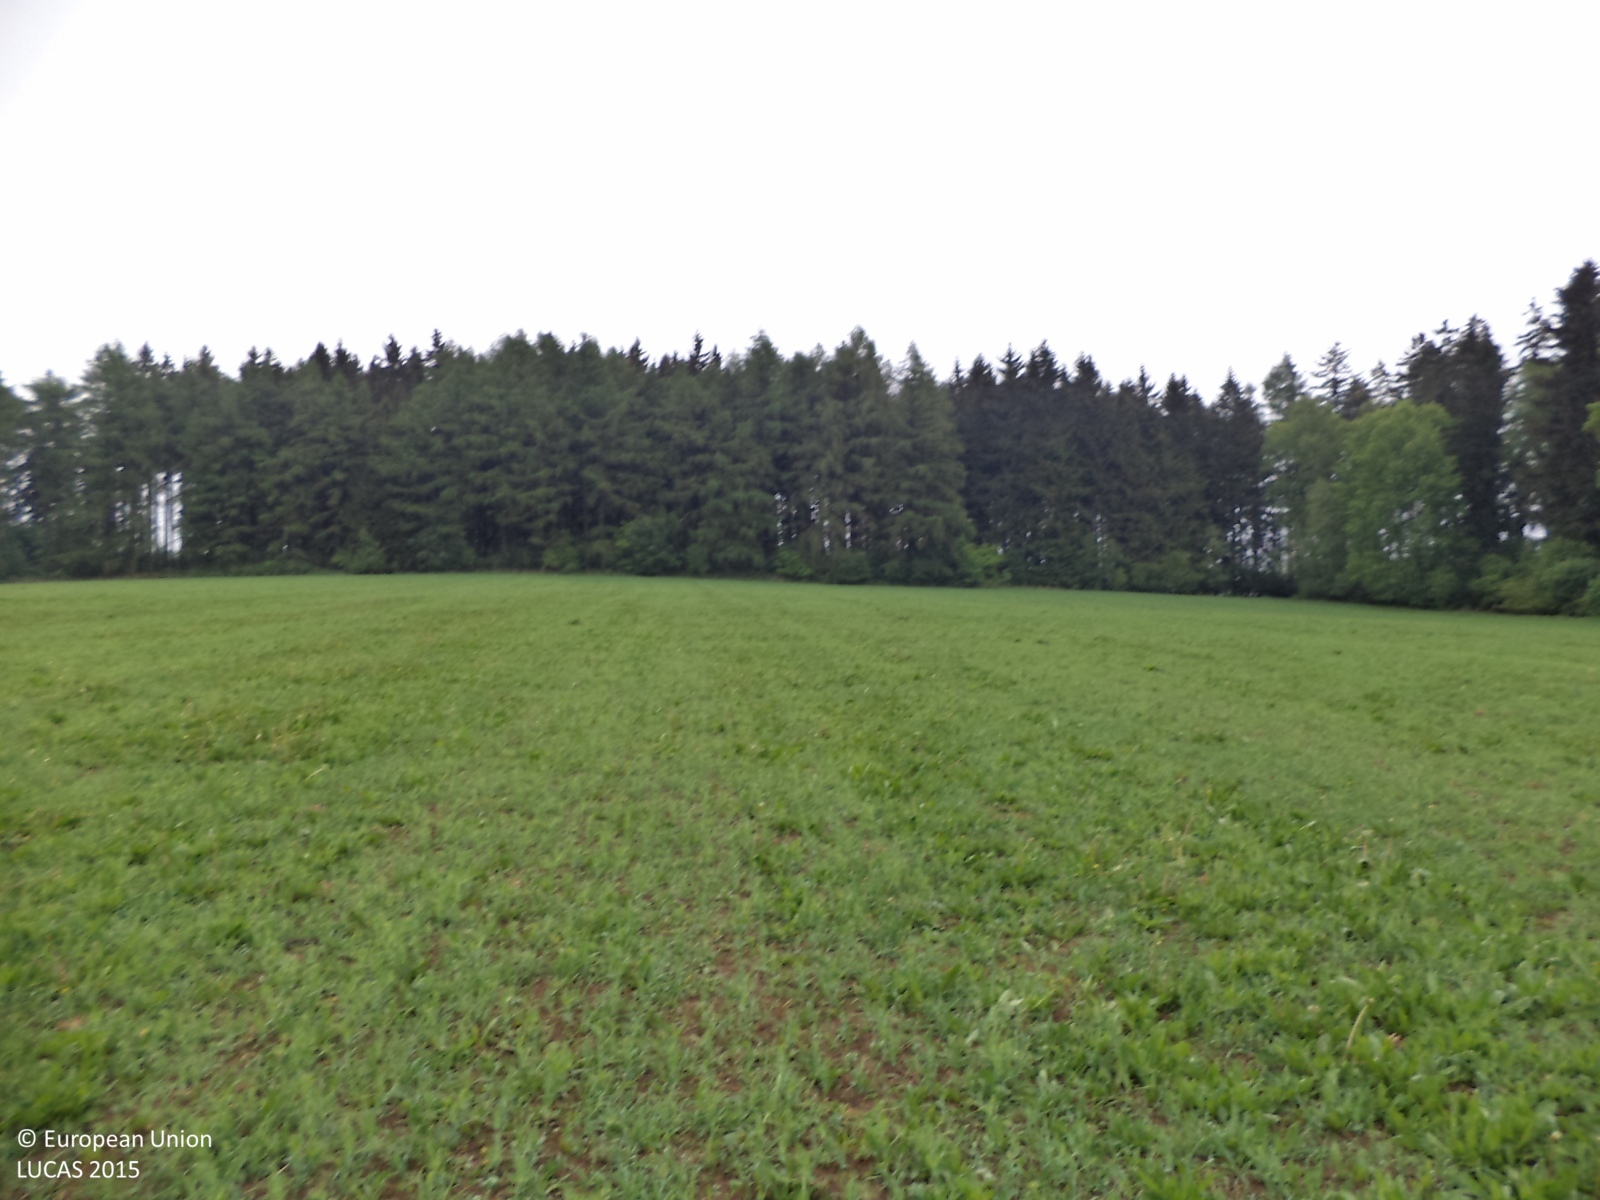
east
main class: Cropland
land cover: Other leguminous and mixtures for fodder
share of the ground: > 75 %
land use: Agriculture (excluding fallow land and kitchen gardens)
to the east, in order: Other leguminous and mixtures for fodder; Spruce dominated coniferous woodland
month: May
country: CZ
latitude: 49.4113
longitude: 14.9228
